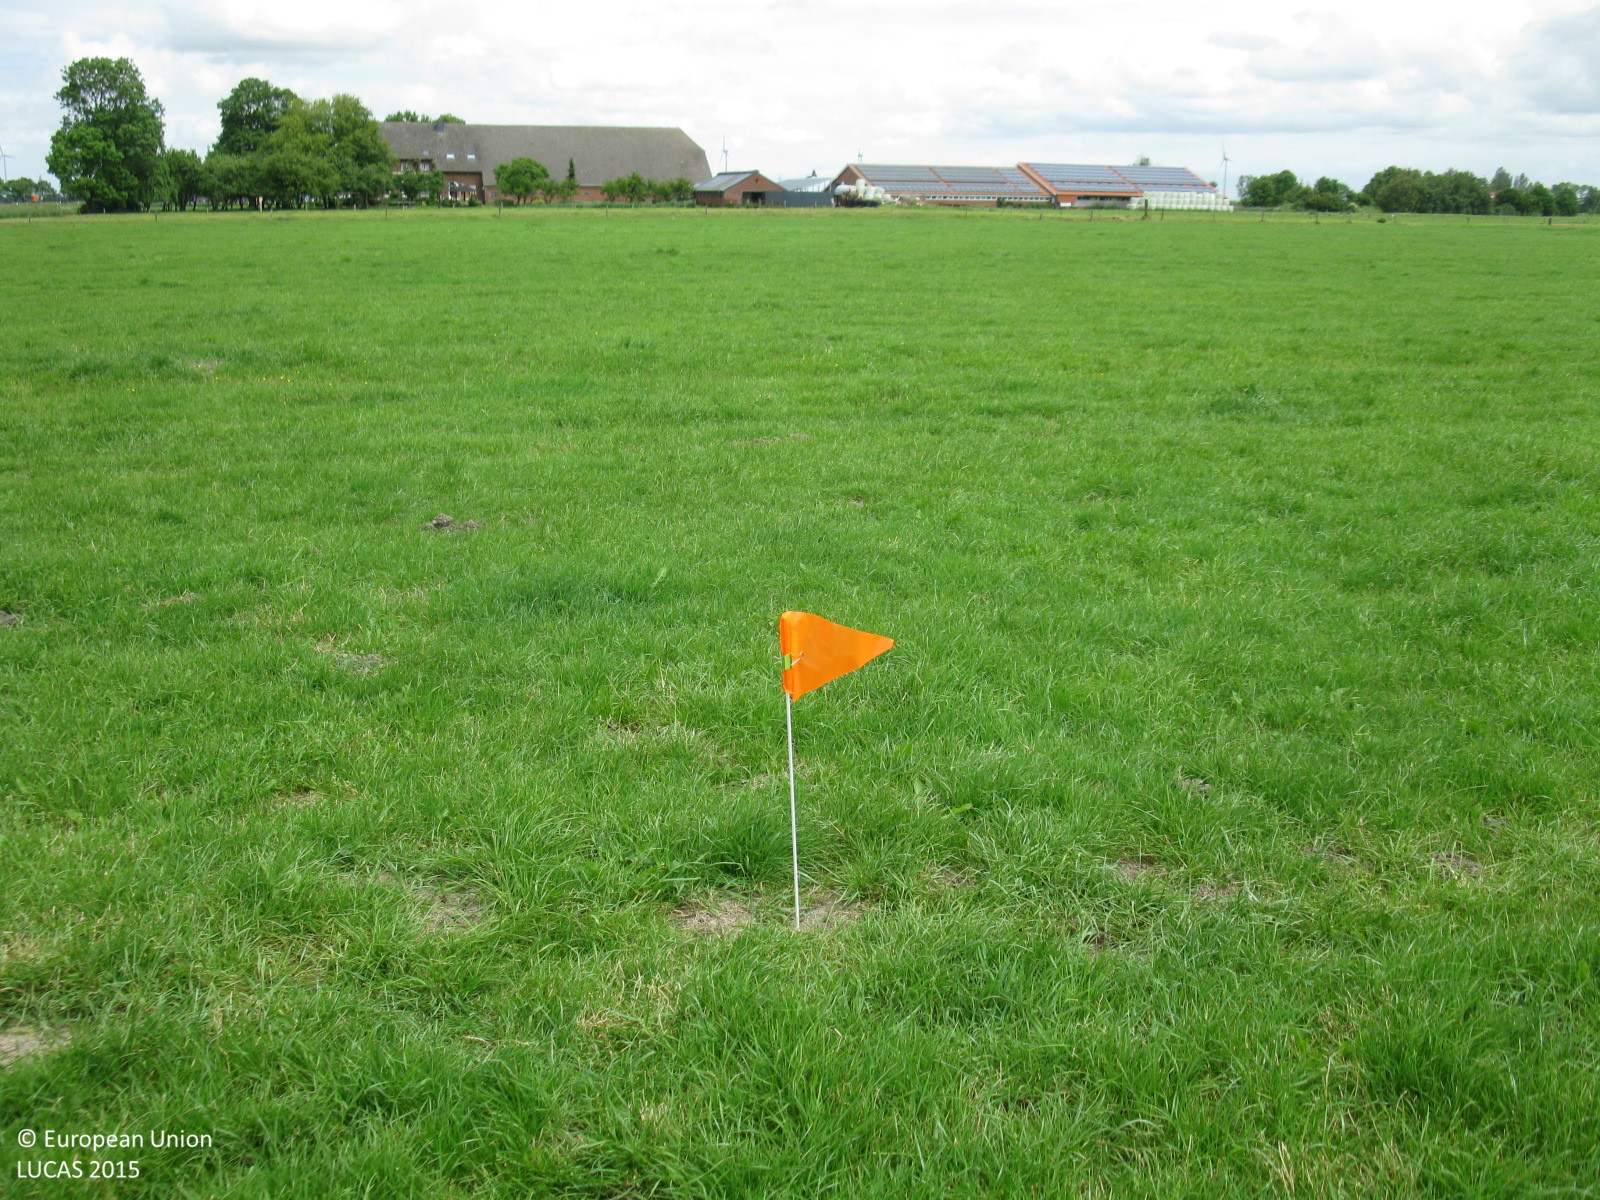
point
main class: Grassland
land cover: Grassland without tree/shrub cover
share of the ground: > 75 %
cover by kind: herbaceous plants 100 %
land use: Agriculture (excluding fallow land and kitchen gardens)
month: June
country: DE
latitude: 53.3368
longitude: 7.3424
